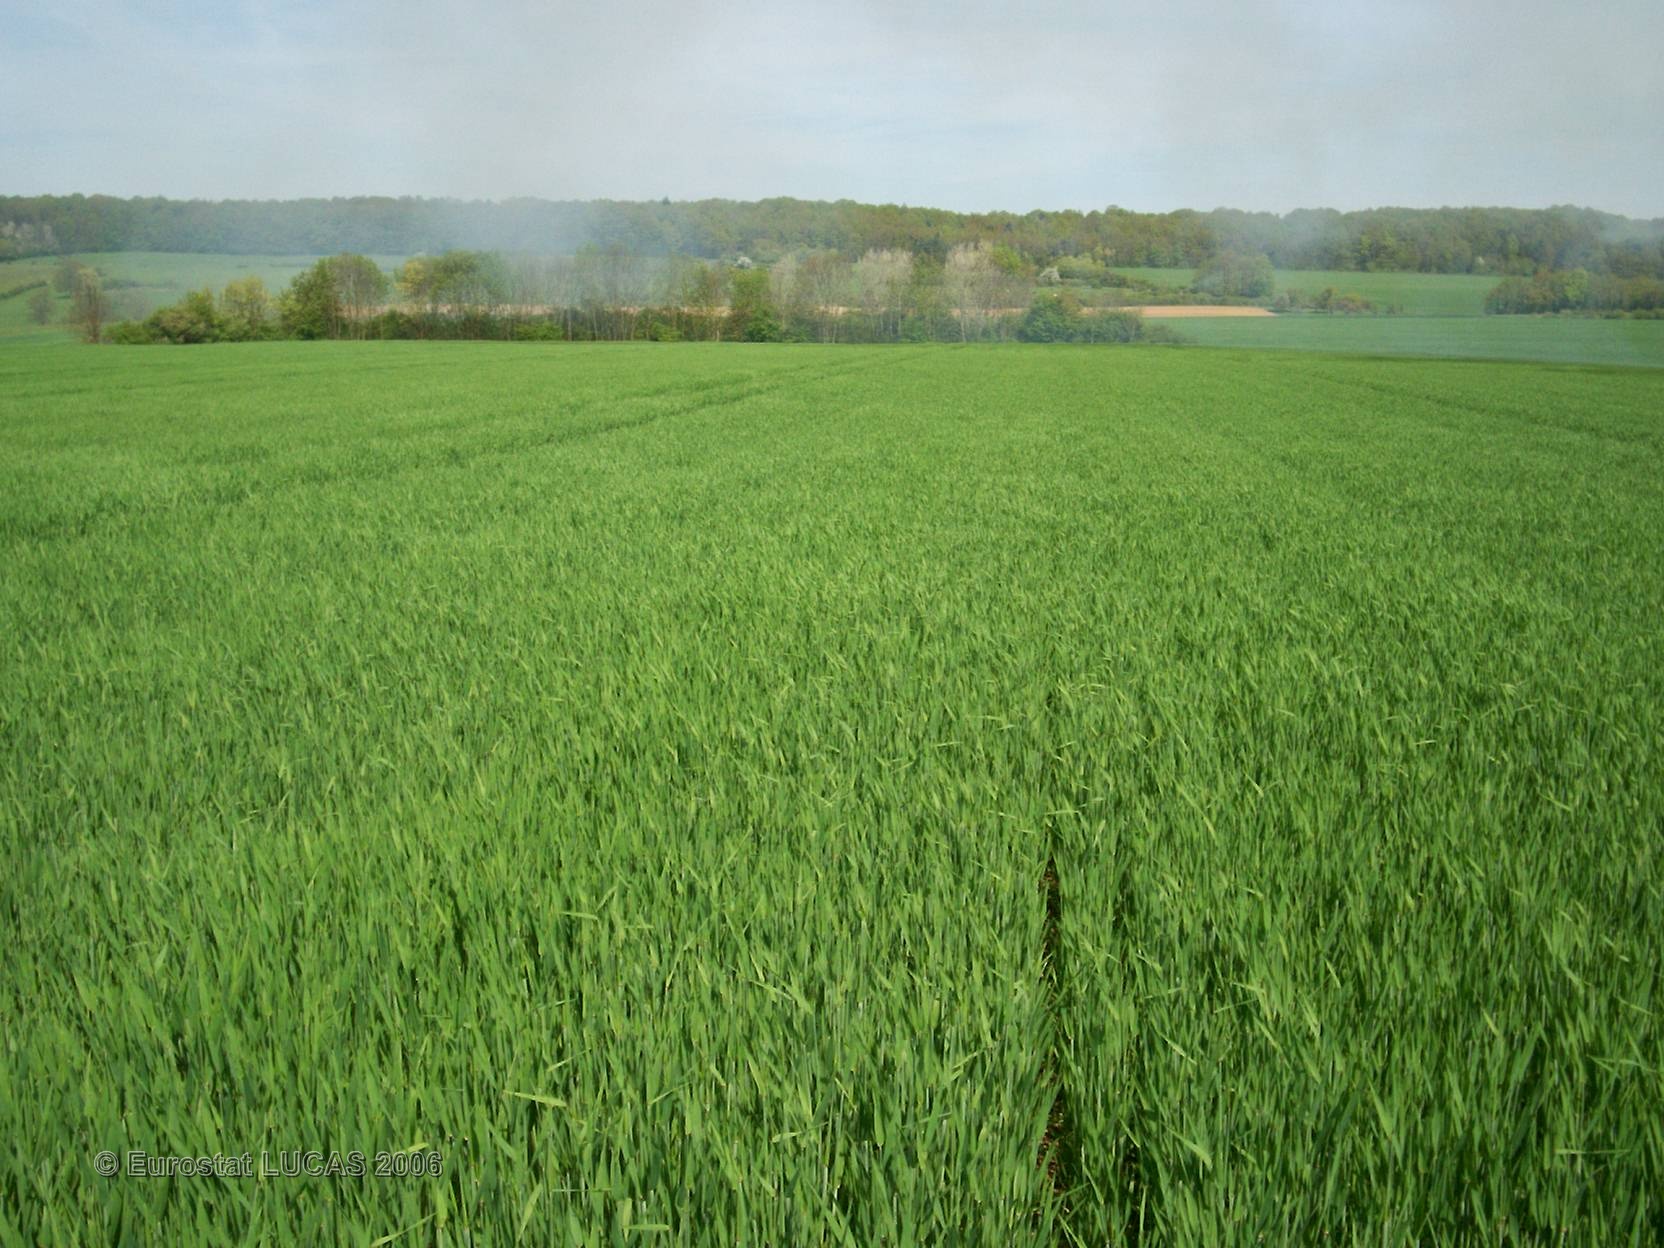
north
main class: Cropland
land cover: Barley
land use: Agriculture (excluding fallow land and kitchen gardens)
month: May
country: FR
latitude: 47.9719
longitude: 4.0359
